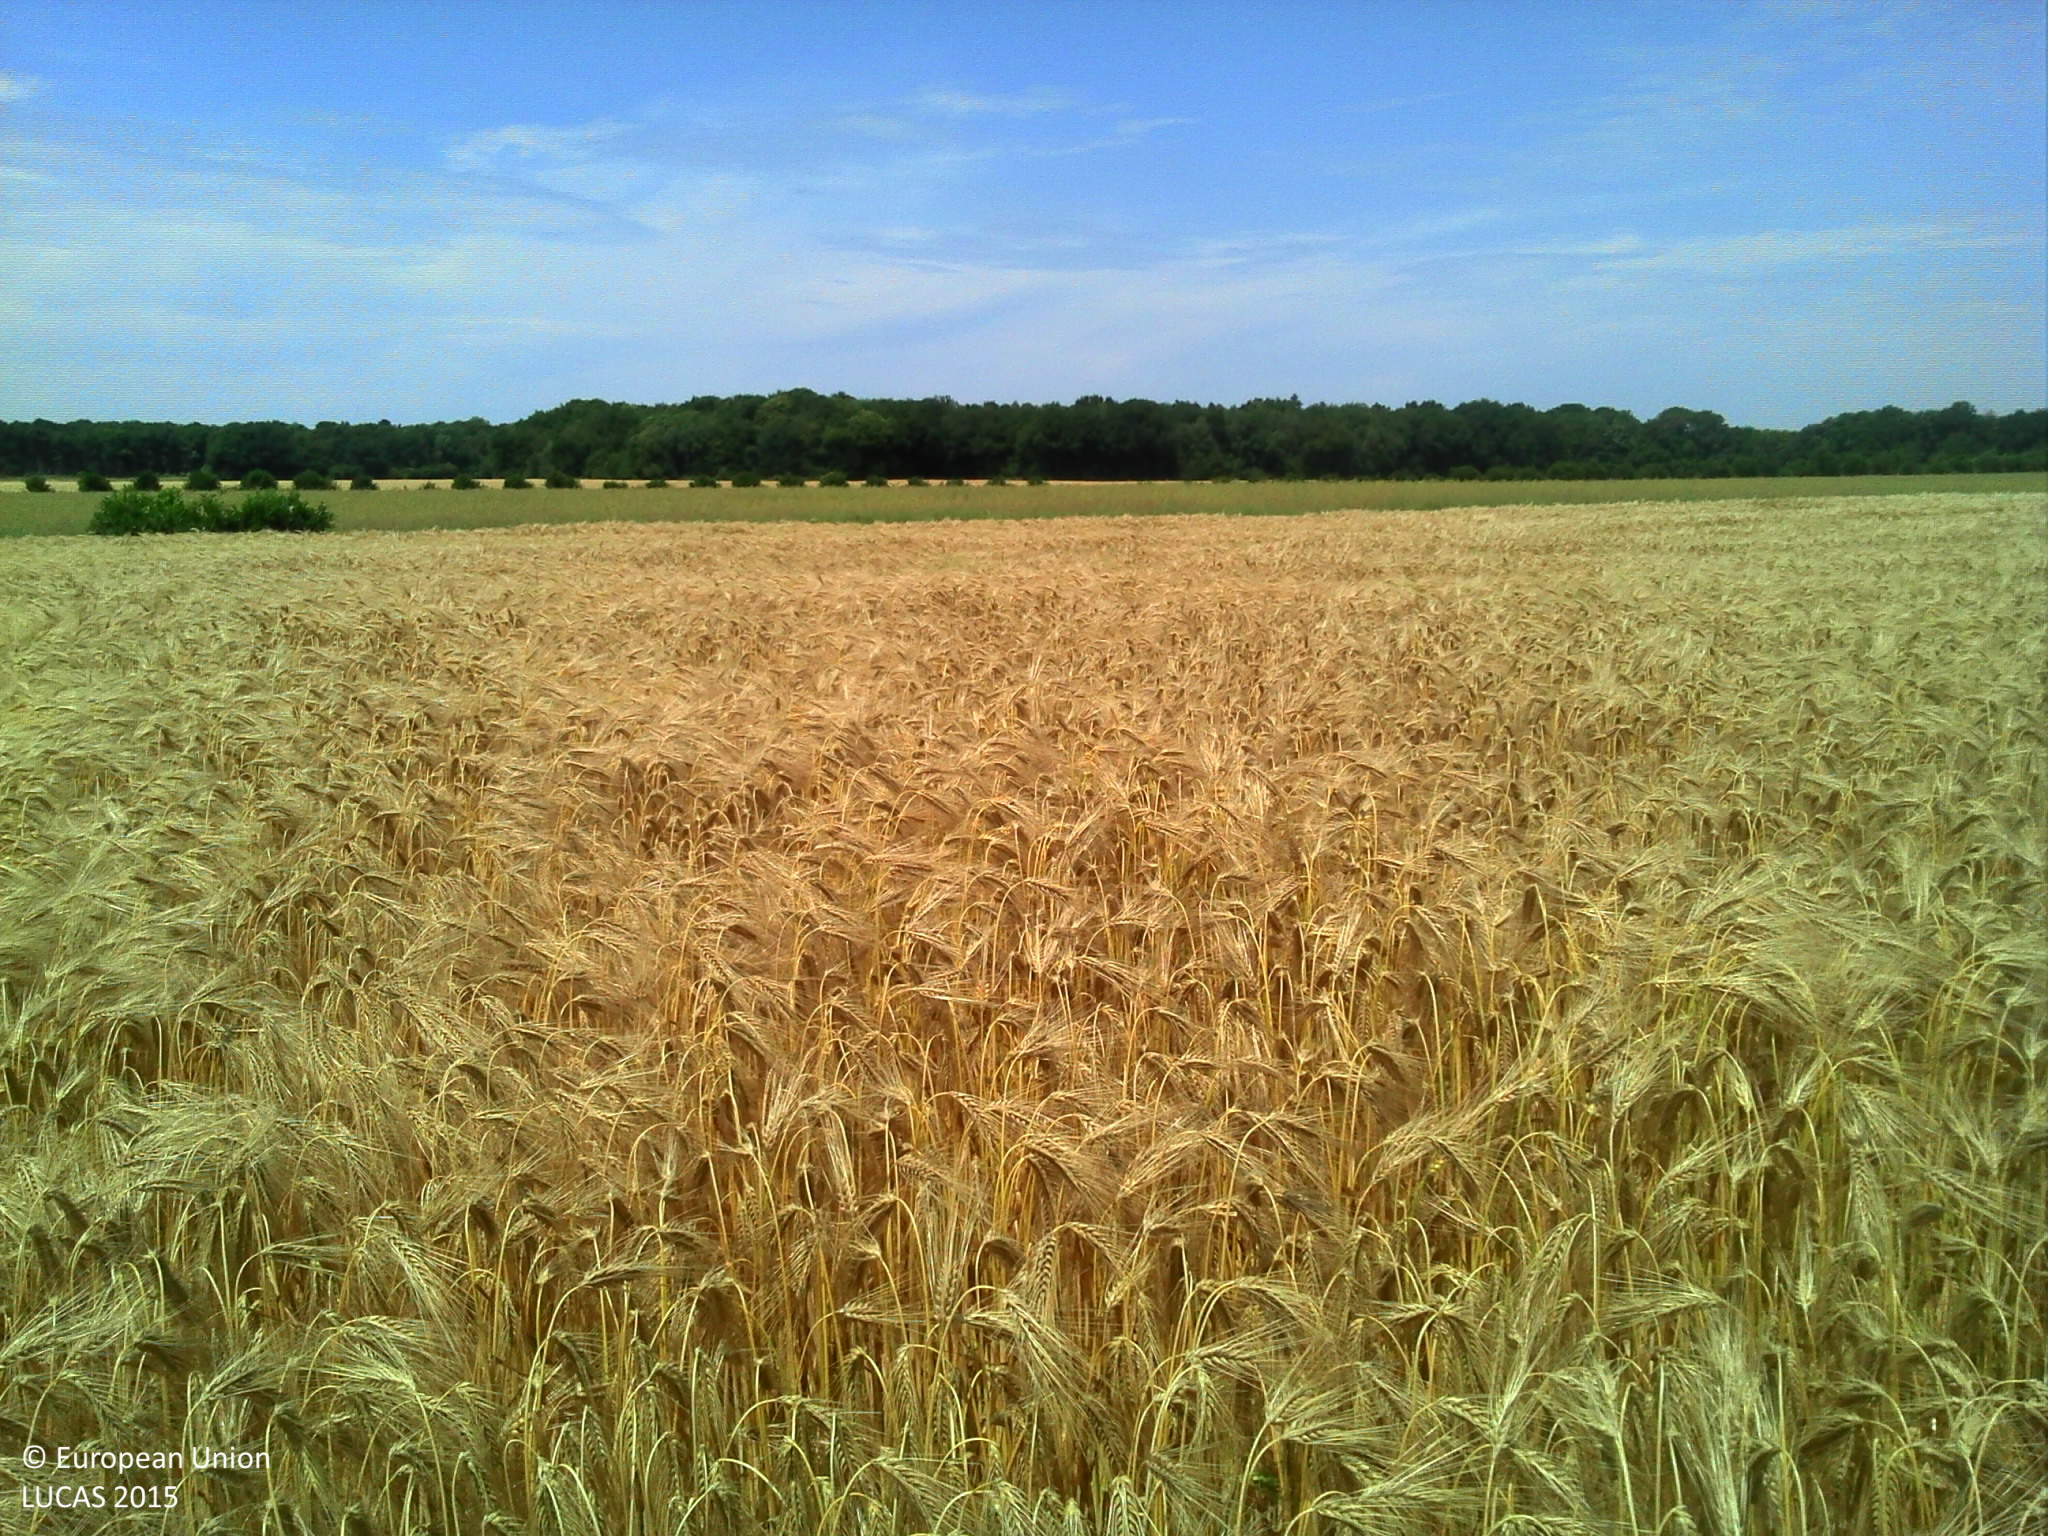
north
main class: Cropland
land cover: Barley
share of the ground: > 75 %
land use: Agriculture (excluding fallow land and kitchen gardens)
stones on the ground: 10 - 25 %
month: June
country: FR
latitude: 49.1017
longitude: 1.2002
